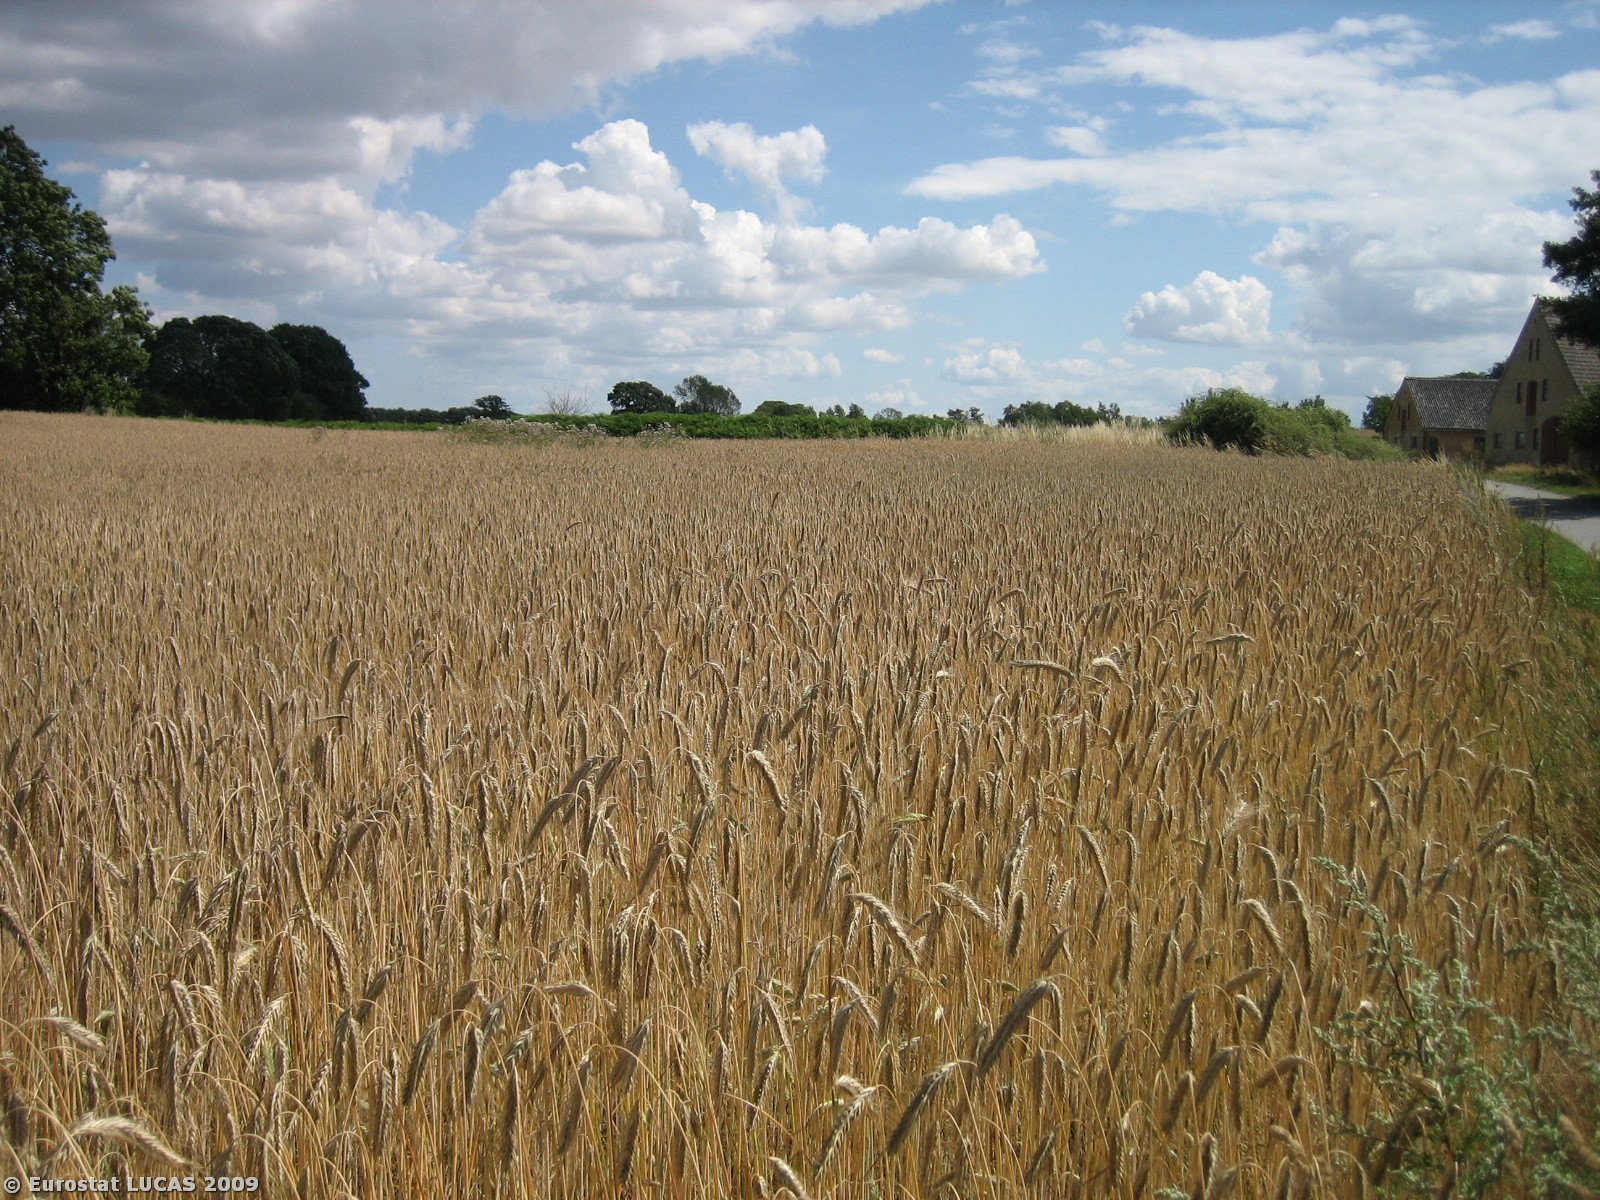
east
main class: Cropland
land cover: Rye
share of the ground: > 75 %
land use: Agriculture (excluding fallow land and kitchen gardens)
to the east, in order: Rye; Shruby margins; Fences; Grassland without tree/shrub cover
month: July
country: DK
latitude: 55.5047
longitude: 10.0158
